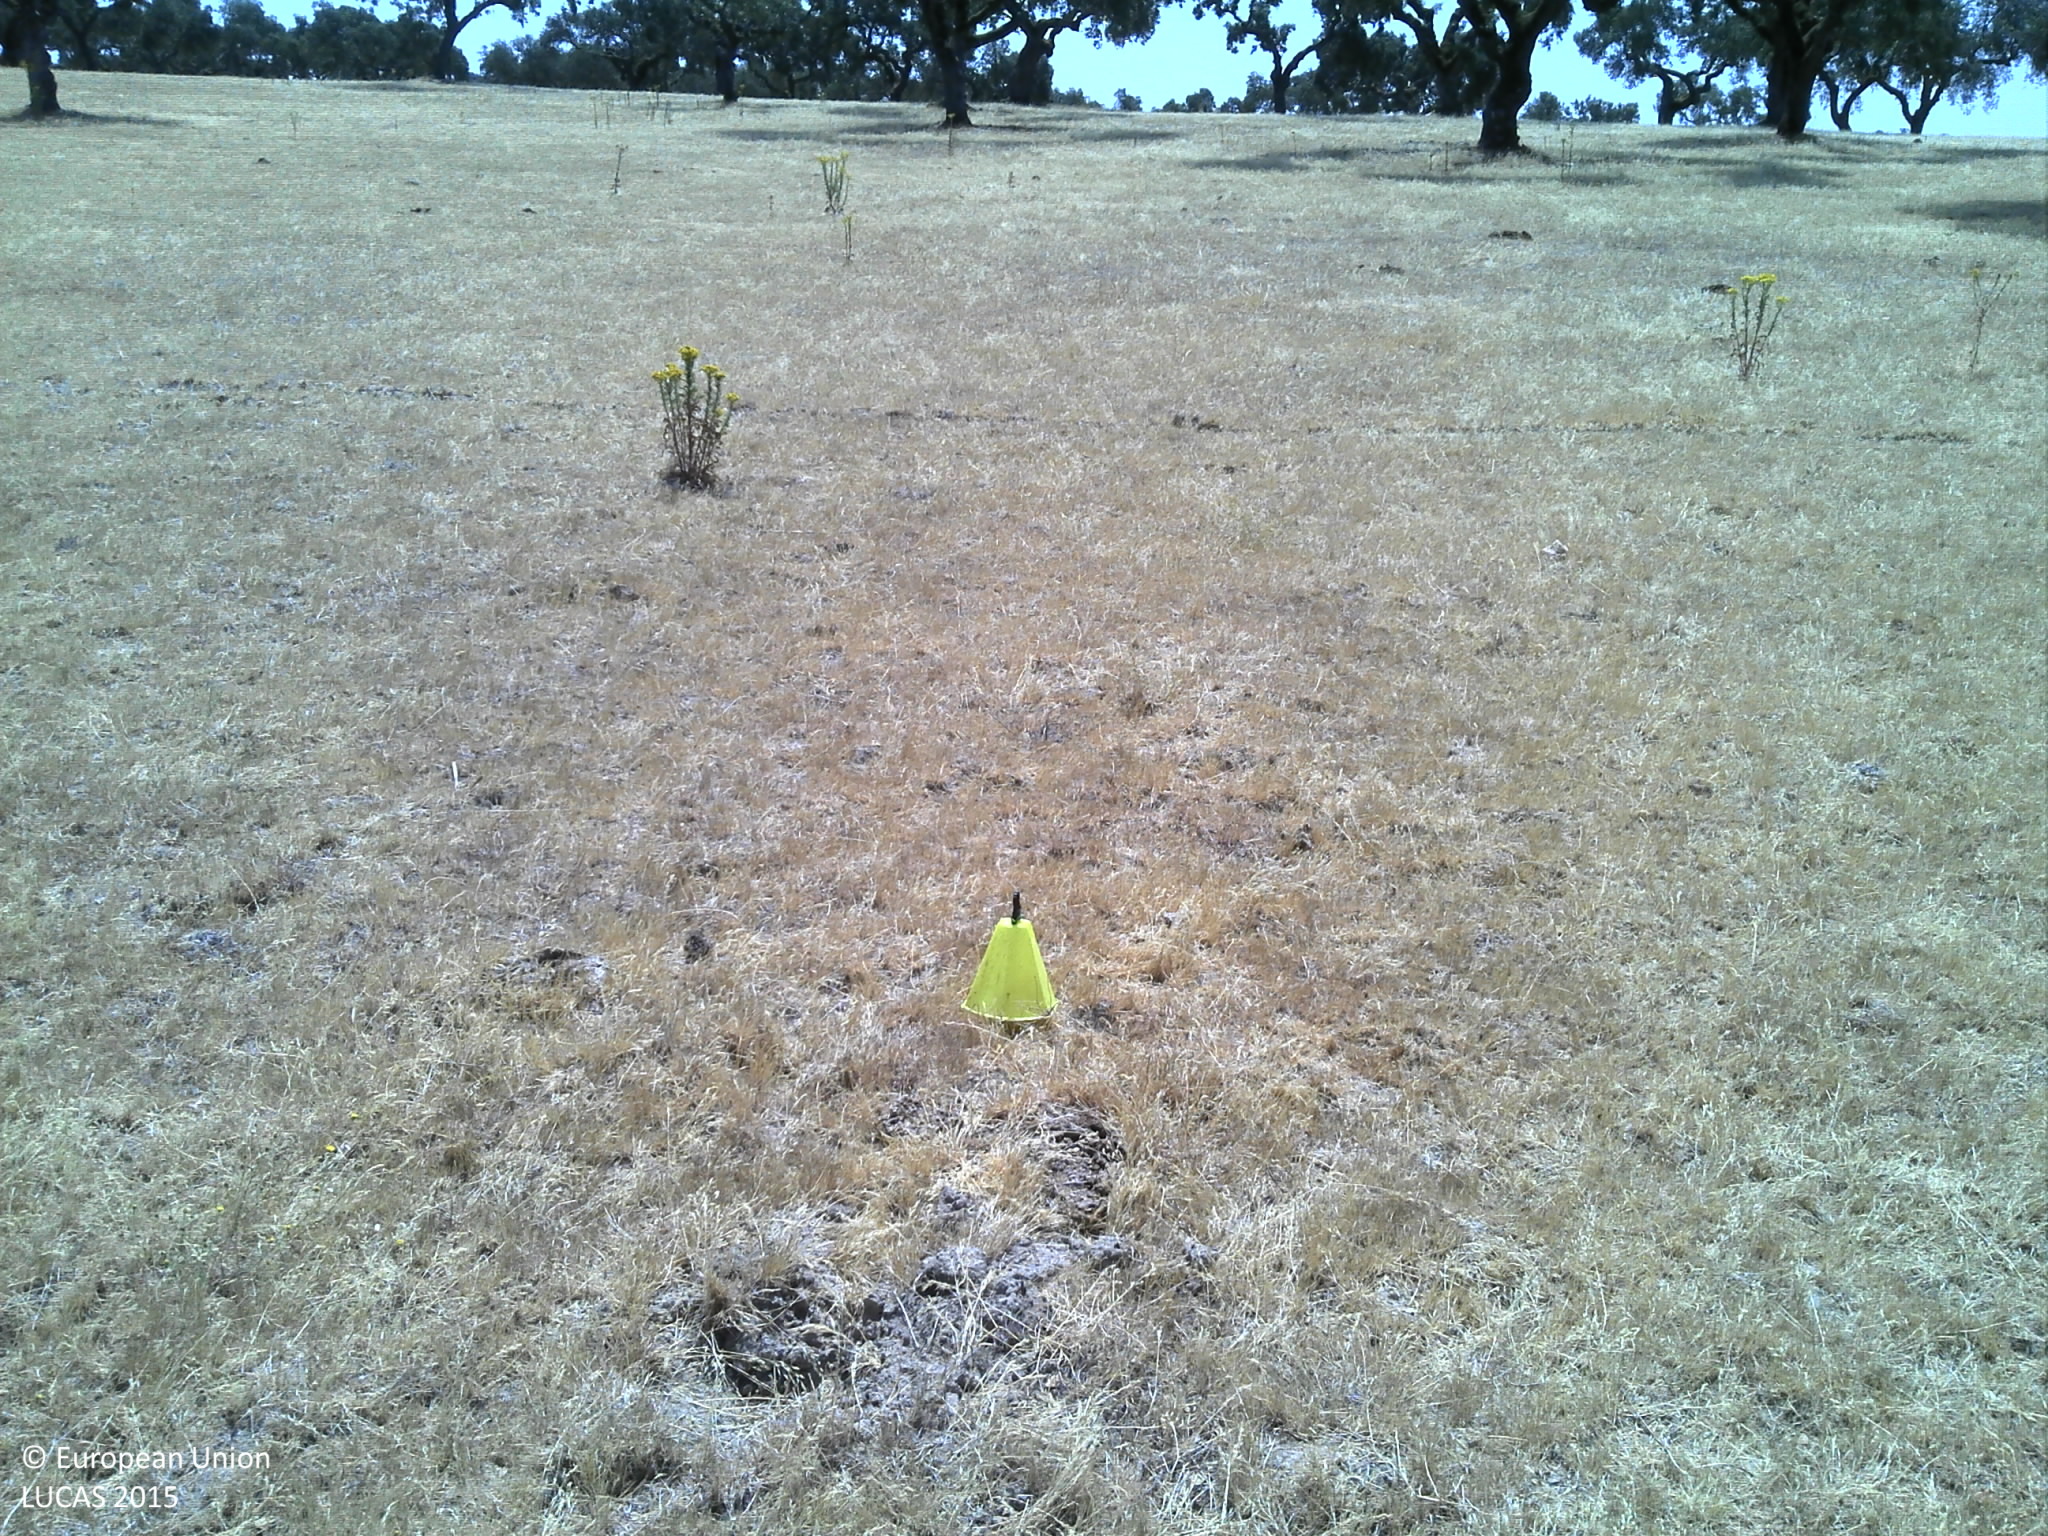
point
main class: Woodland
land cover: Broadleaved woodland
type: broadleaved evergreen forest
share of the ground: 10 - 25 %
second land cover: Grassland without tree/shrub cover
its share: 50 - 75 %
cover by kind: herbaceous plants 60 %, unconsolidated bare surface 25 %, broadleaved forest trees 15 %
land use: Forestry
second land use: Agriculture (excluding fallow land and kitchen gardens)
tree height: > 5 m
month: July
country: PT
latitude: 38.6972
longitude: -7.7093
